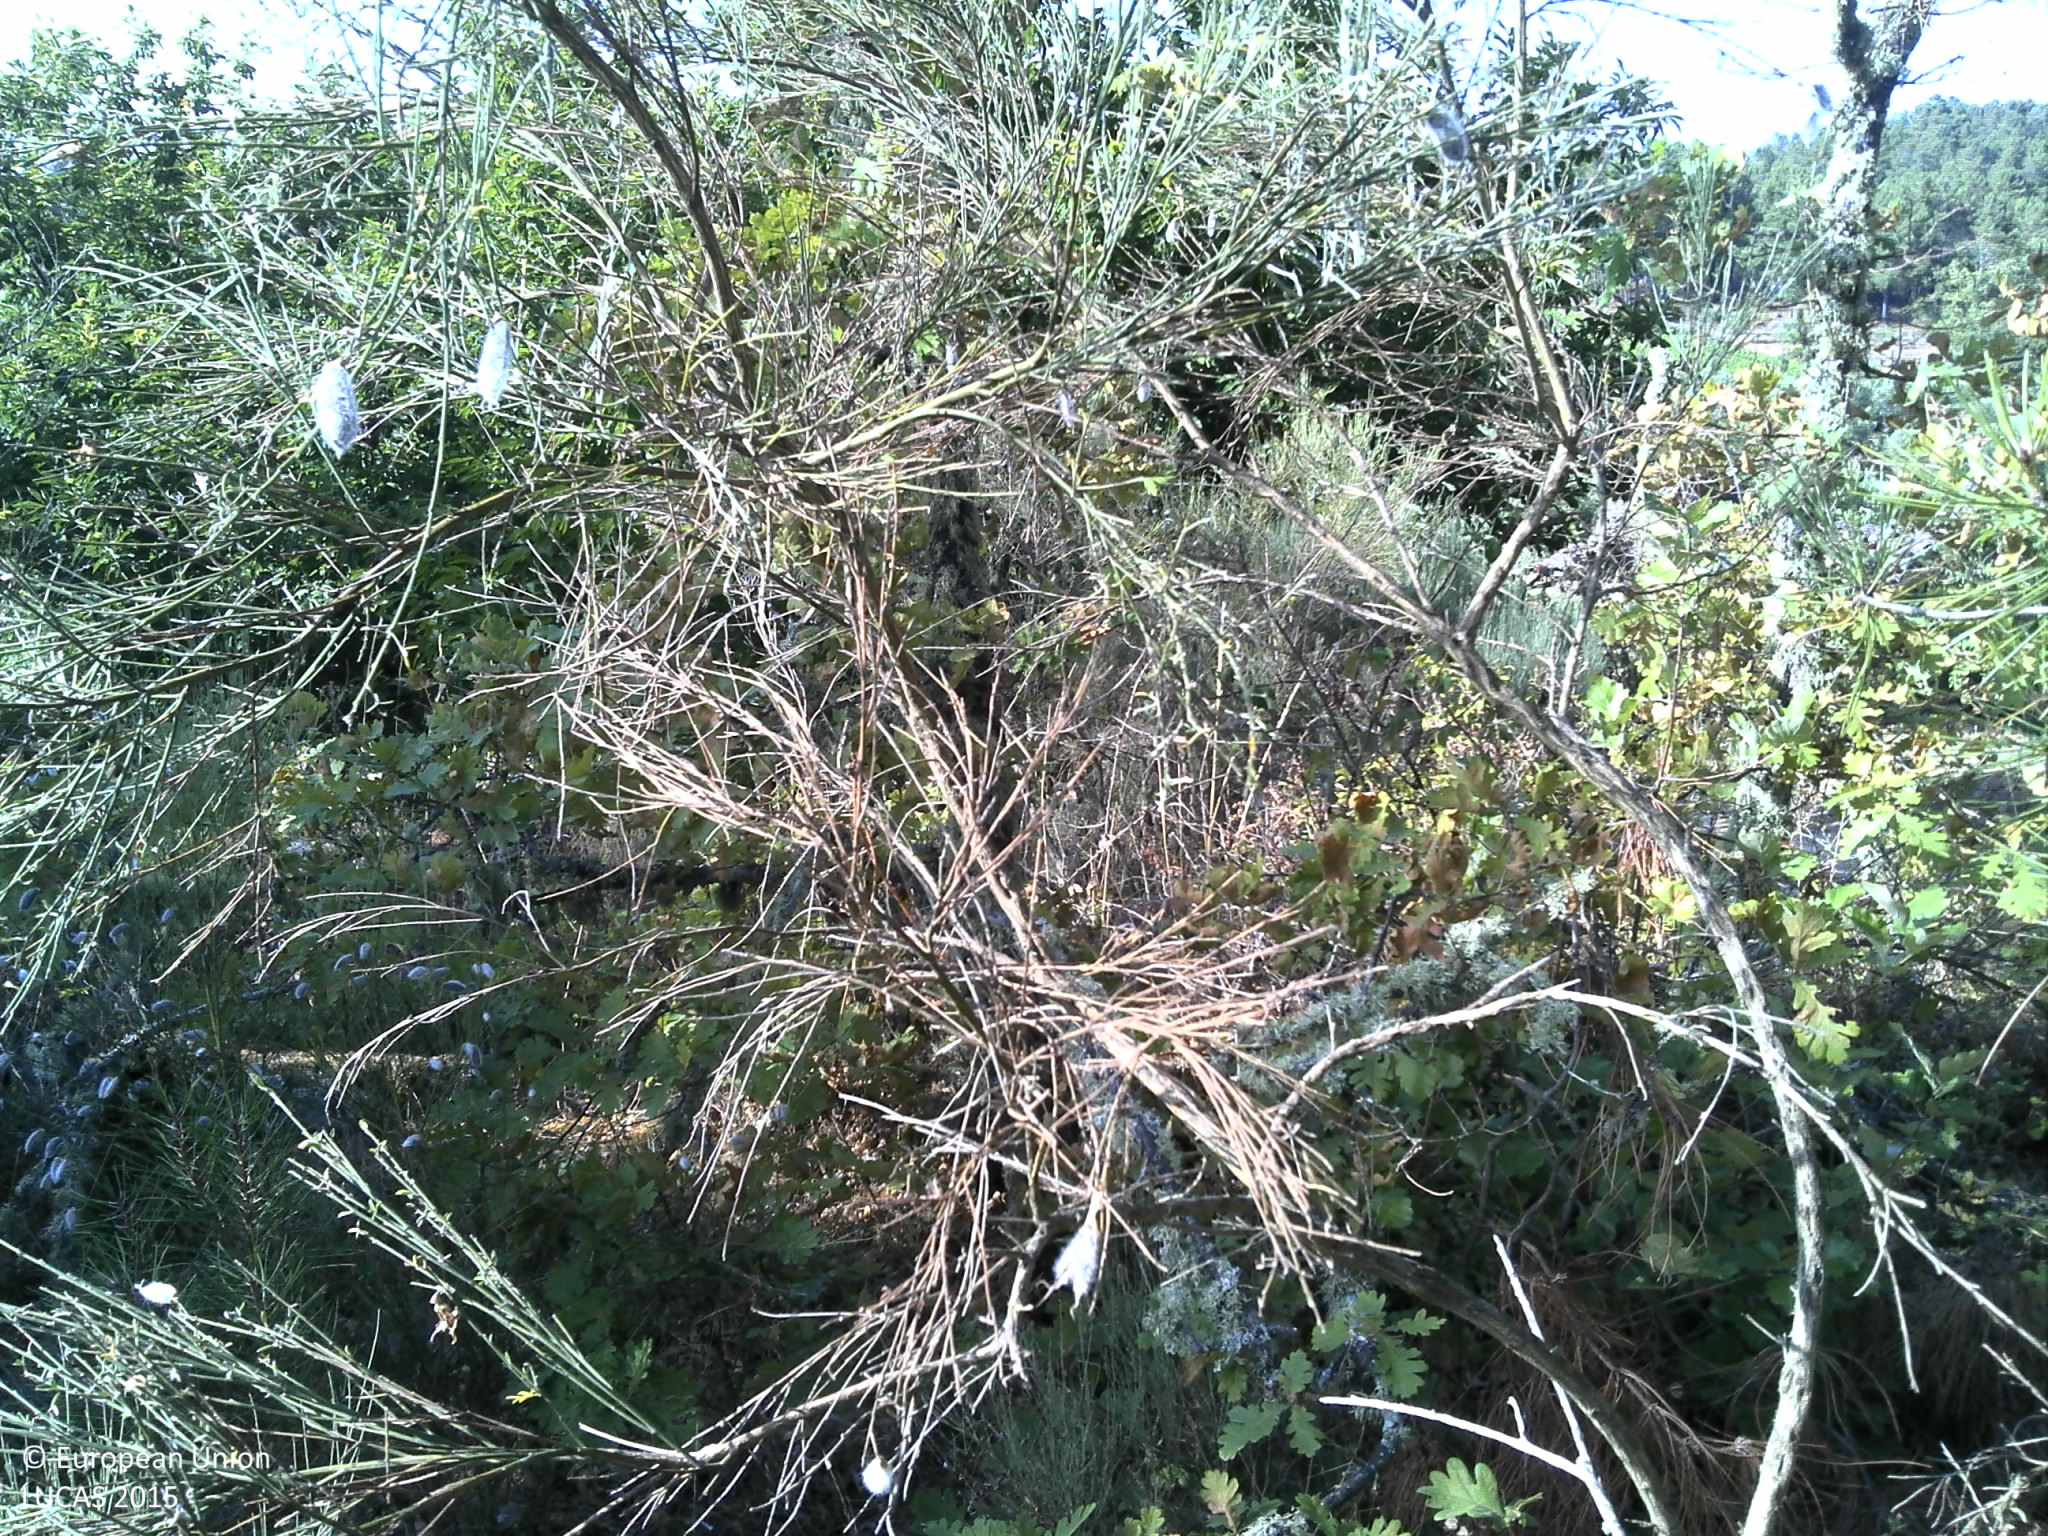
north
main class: Woodland
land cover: Pine dominated mixed woodland
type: coniferous forest of the mediterranean region
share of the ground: 25 - 50 %
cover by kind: coniferous forest trees 30 %, shrubs 30 %, unconsolidated bare surface 25 %, broadleaved forest trees 15 %
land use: Forestry
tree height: > 5 m
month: July
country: PT
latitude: 40.9507
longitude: -7.4984
